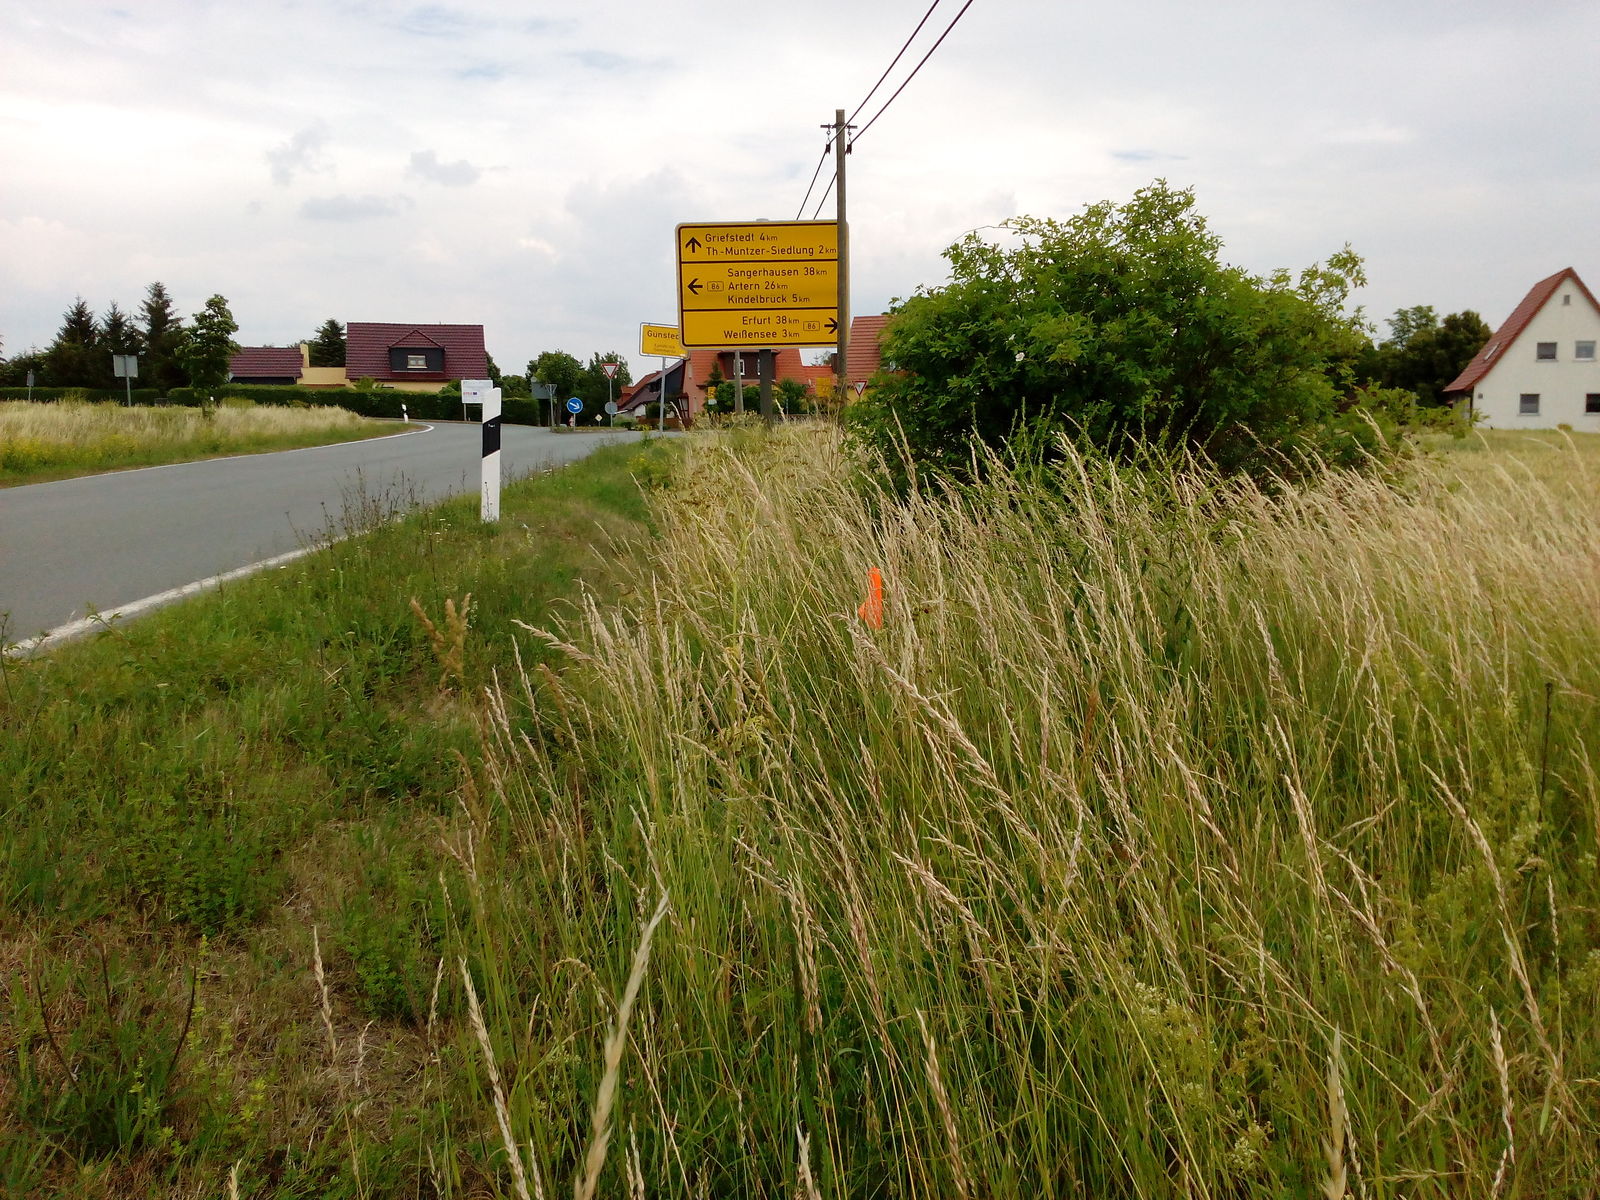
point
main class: Grassland
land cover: Grassland without tree/shrub cover
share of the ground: > 75 %
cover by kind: herbaceous plants 95 %, shrubs 5 %
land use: Agriculture (excluding fallow land and kitchen gardens)
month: June
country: DE
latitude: 51.2221
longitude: 11.0736
